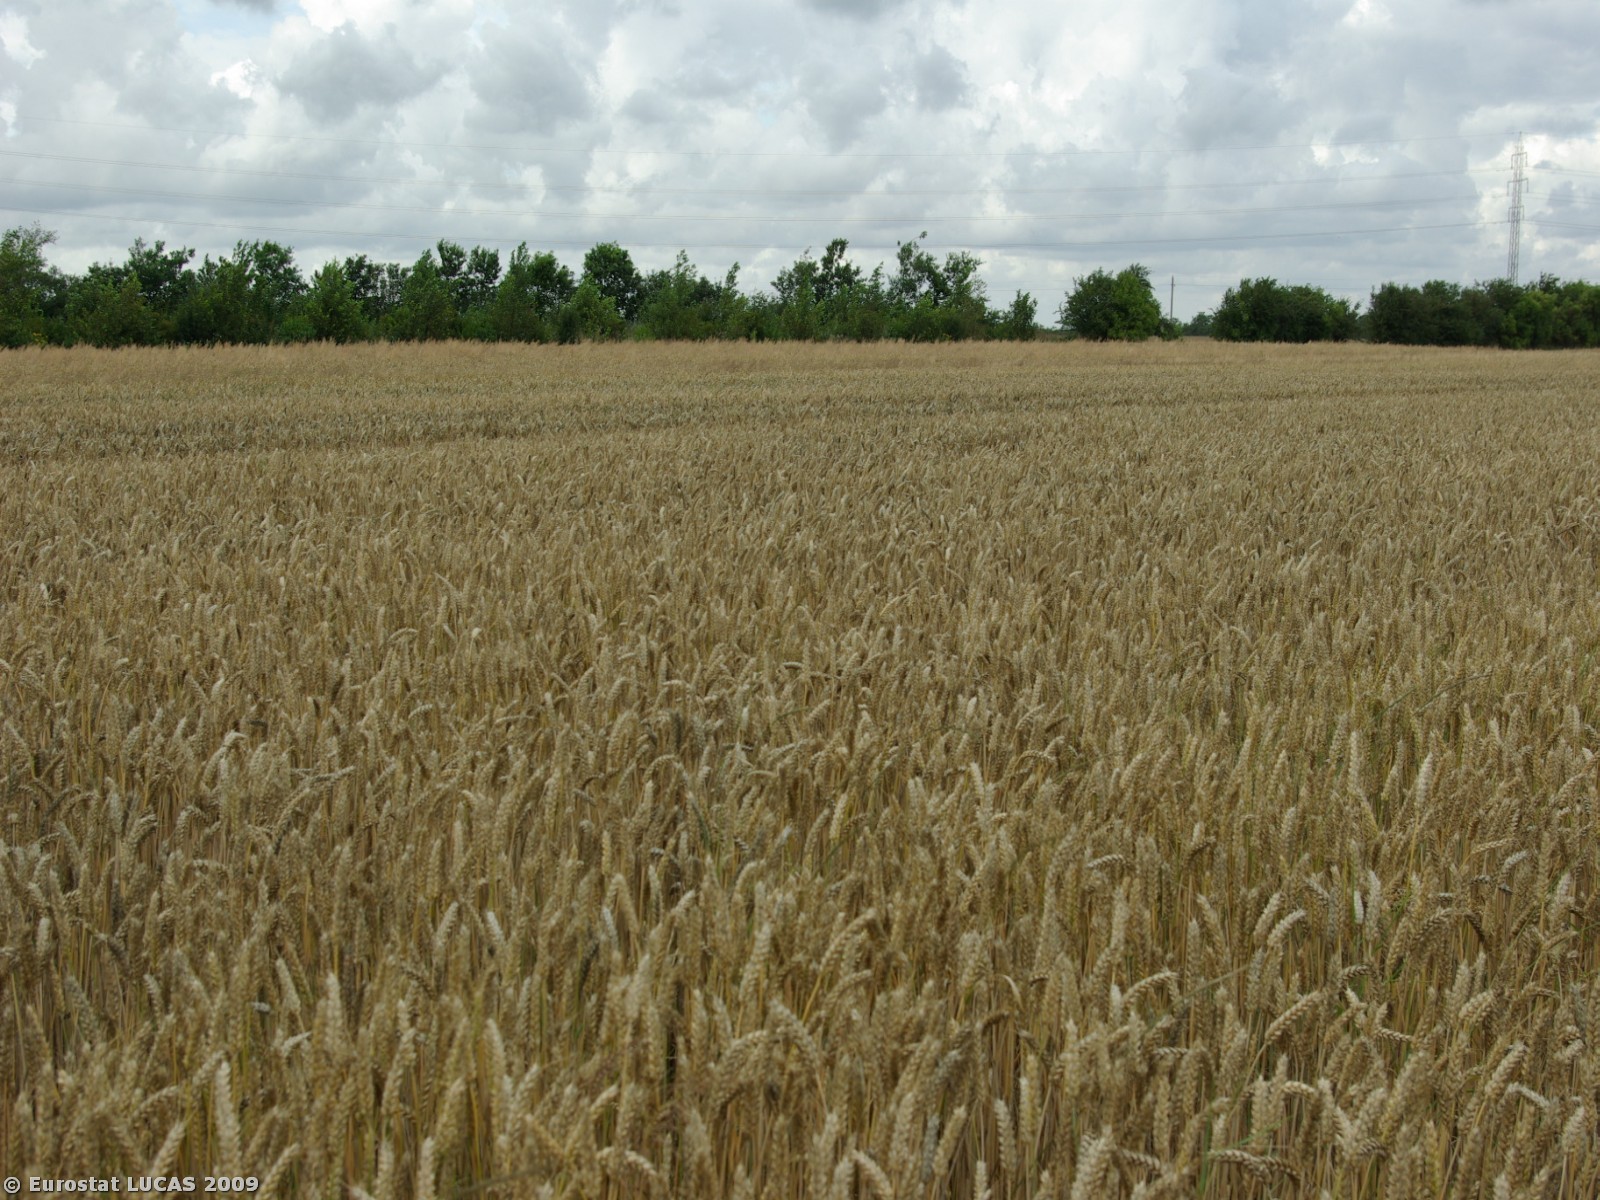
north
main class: Cropland
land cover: Common wheat
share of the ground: > 75 %
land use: Agriculture (excluding fallow land and kitchen gardens)
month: July
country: DK
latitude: 55.0335
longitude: 9.0151
